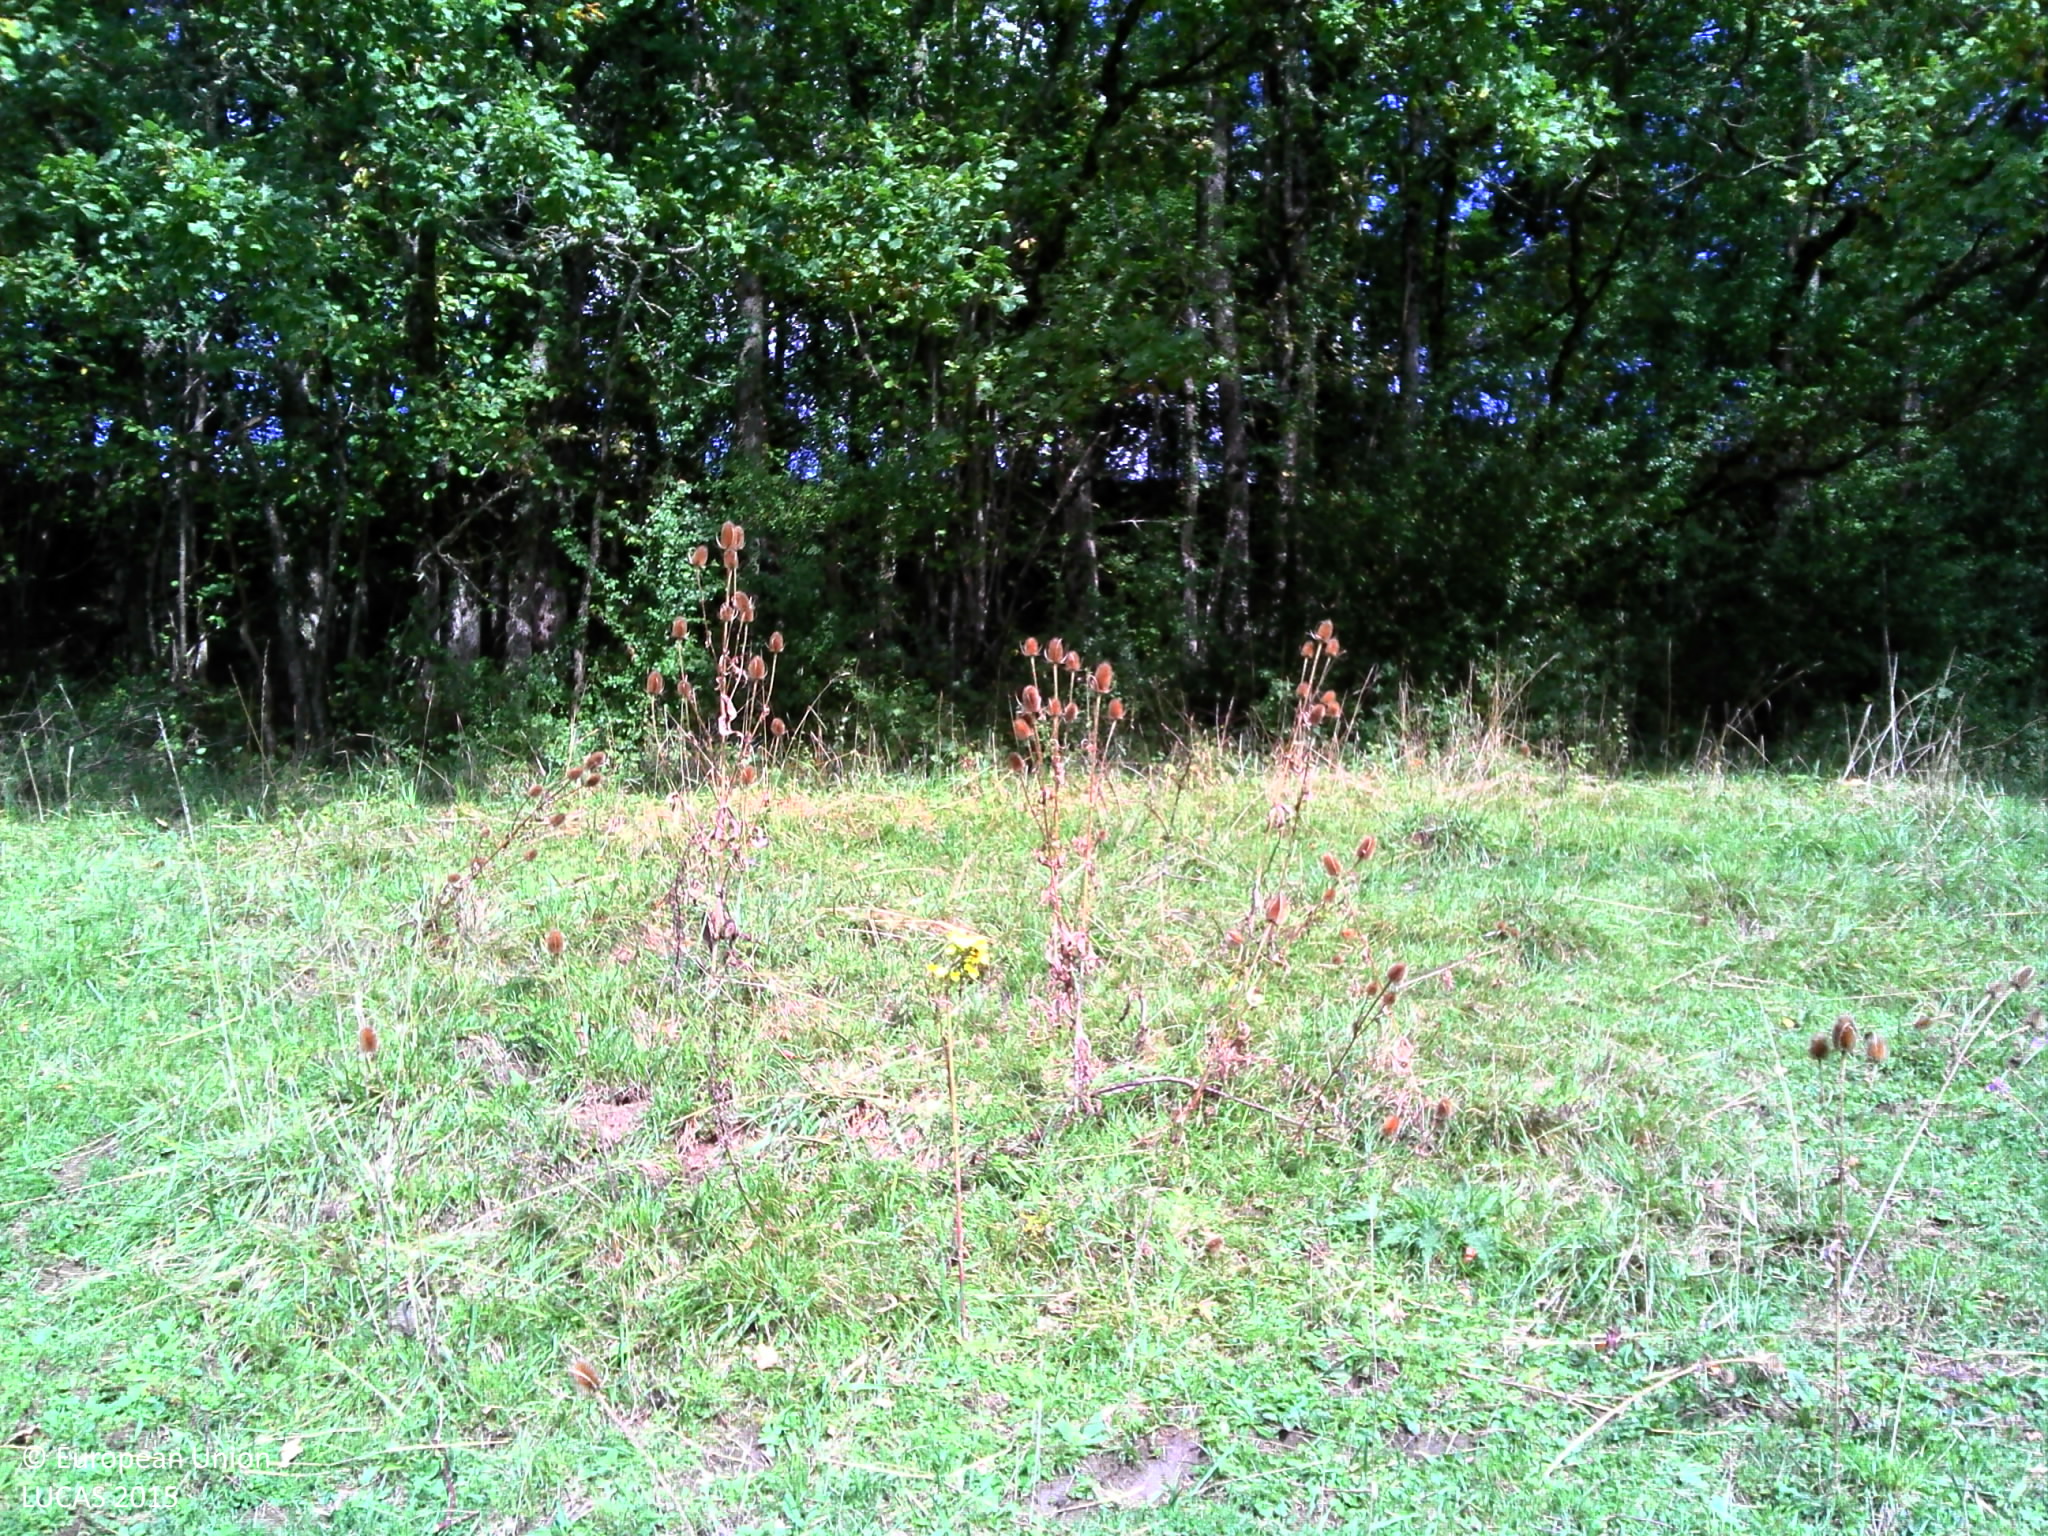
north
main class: Grassland
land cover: Grassland without tree/shrub cover
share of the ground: > 75 %
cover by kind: herbaceous plants 100 %
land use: Agriculture (excluding fallow land and kitchen gardens)
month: September
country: FR
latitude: 47.1335
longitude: 6.2710
